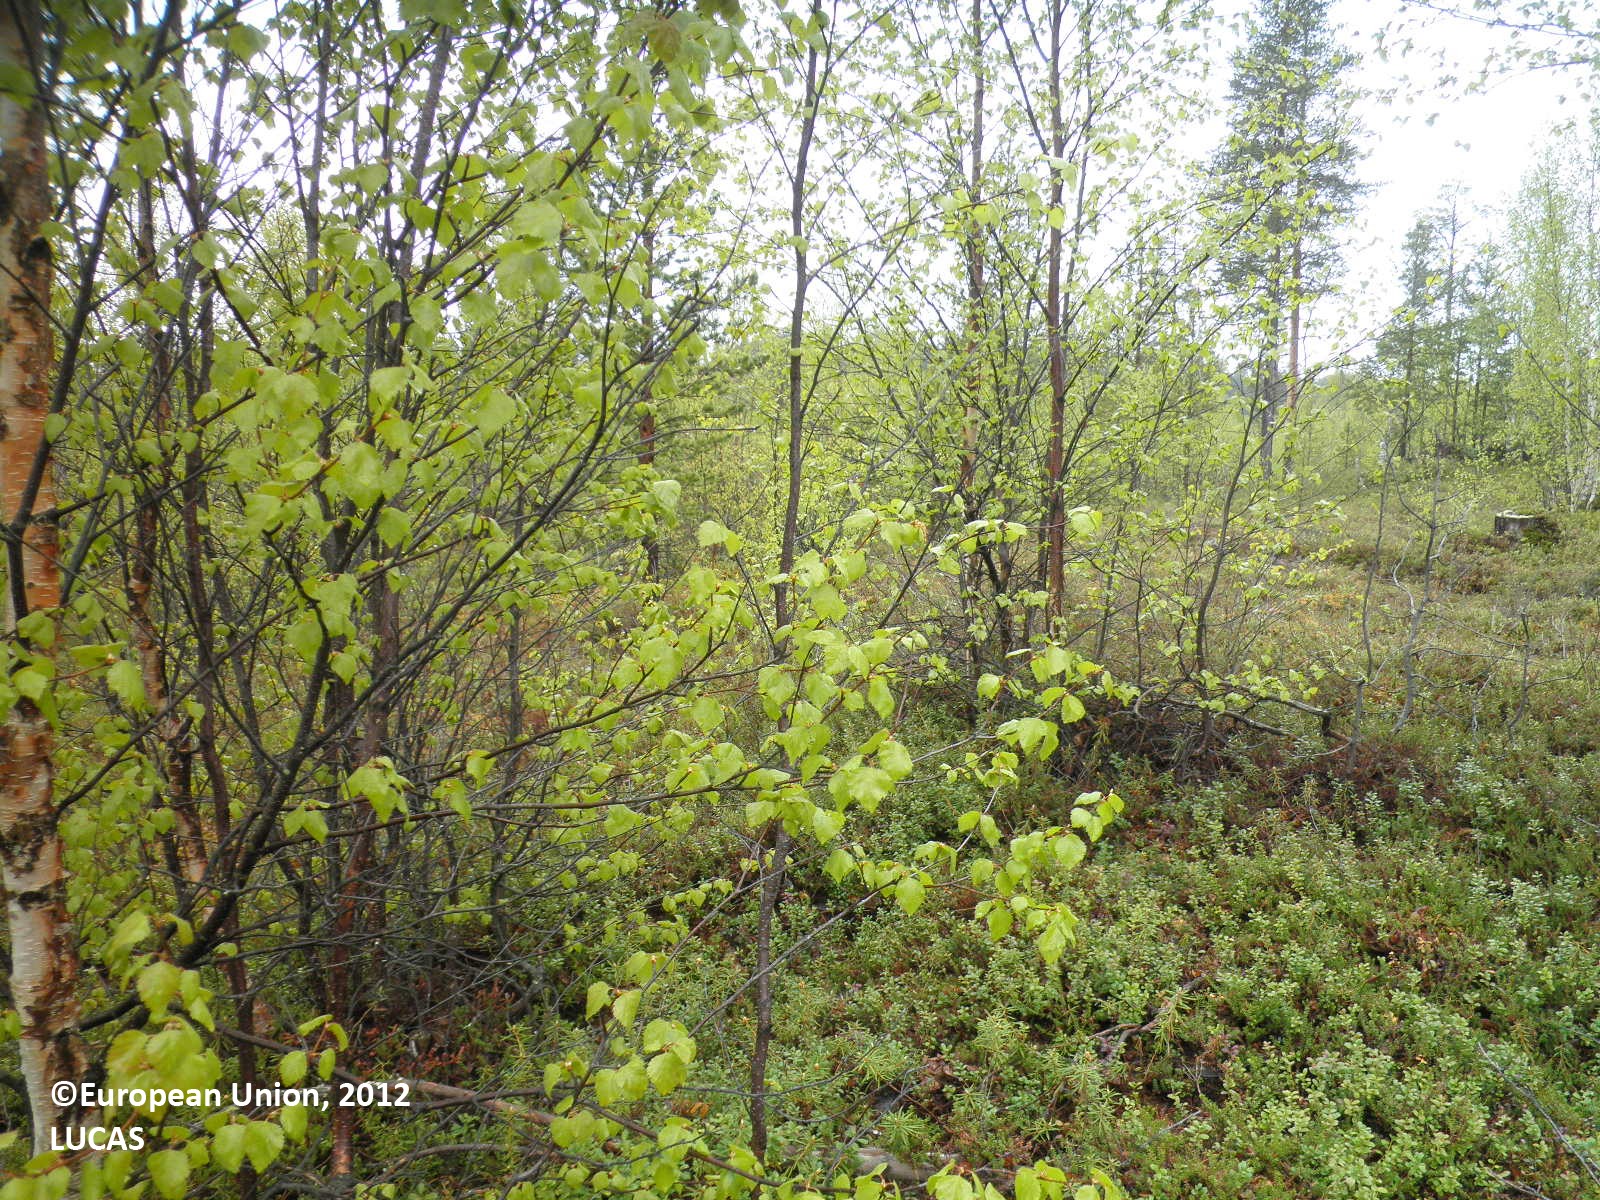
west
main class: Woodland
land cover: Pine dominated mixed woodland
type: boreal forest
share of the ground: 50 - 75 %
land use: Forestry
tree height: > 5 m
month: June
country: FI
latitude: 68.7940
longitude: 27.8459
